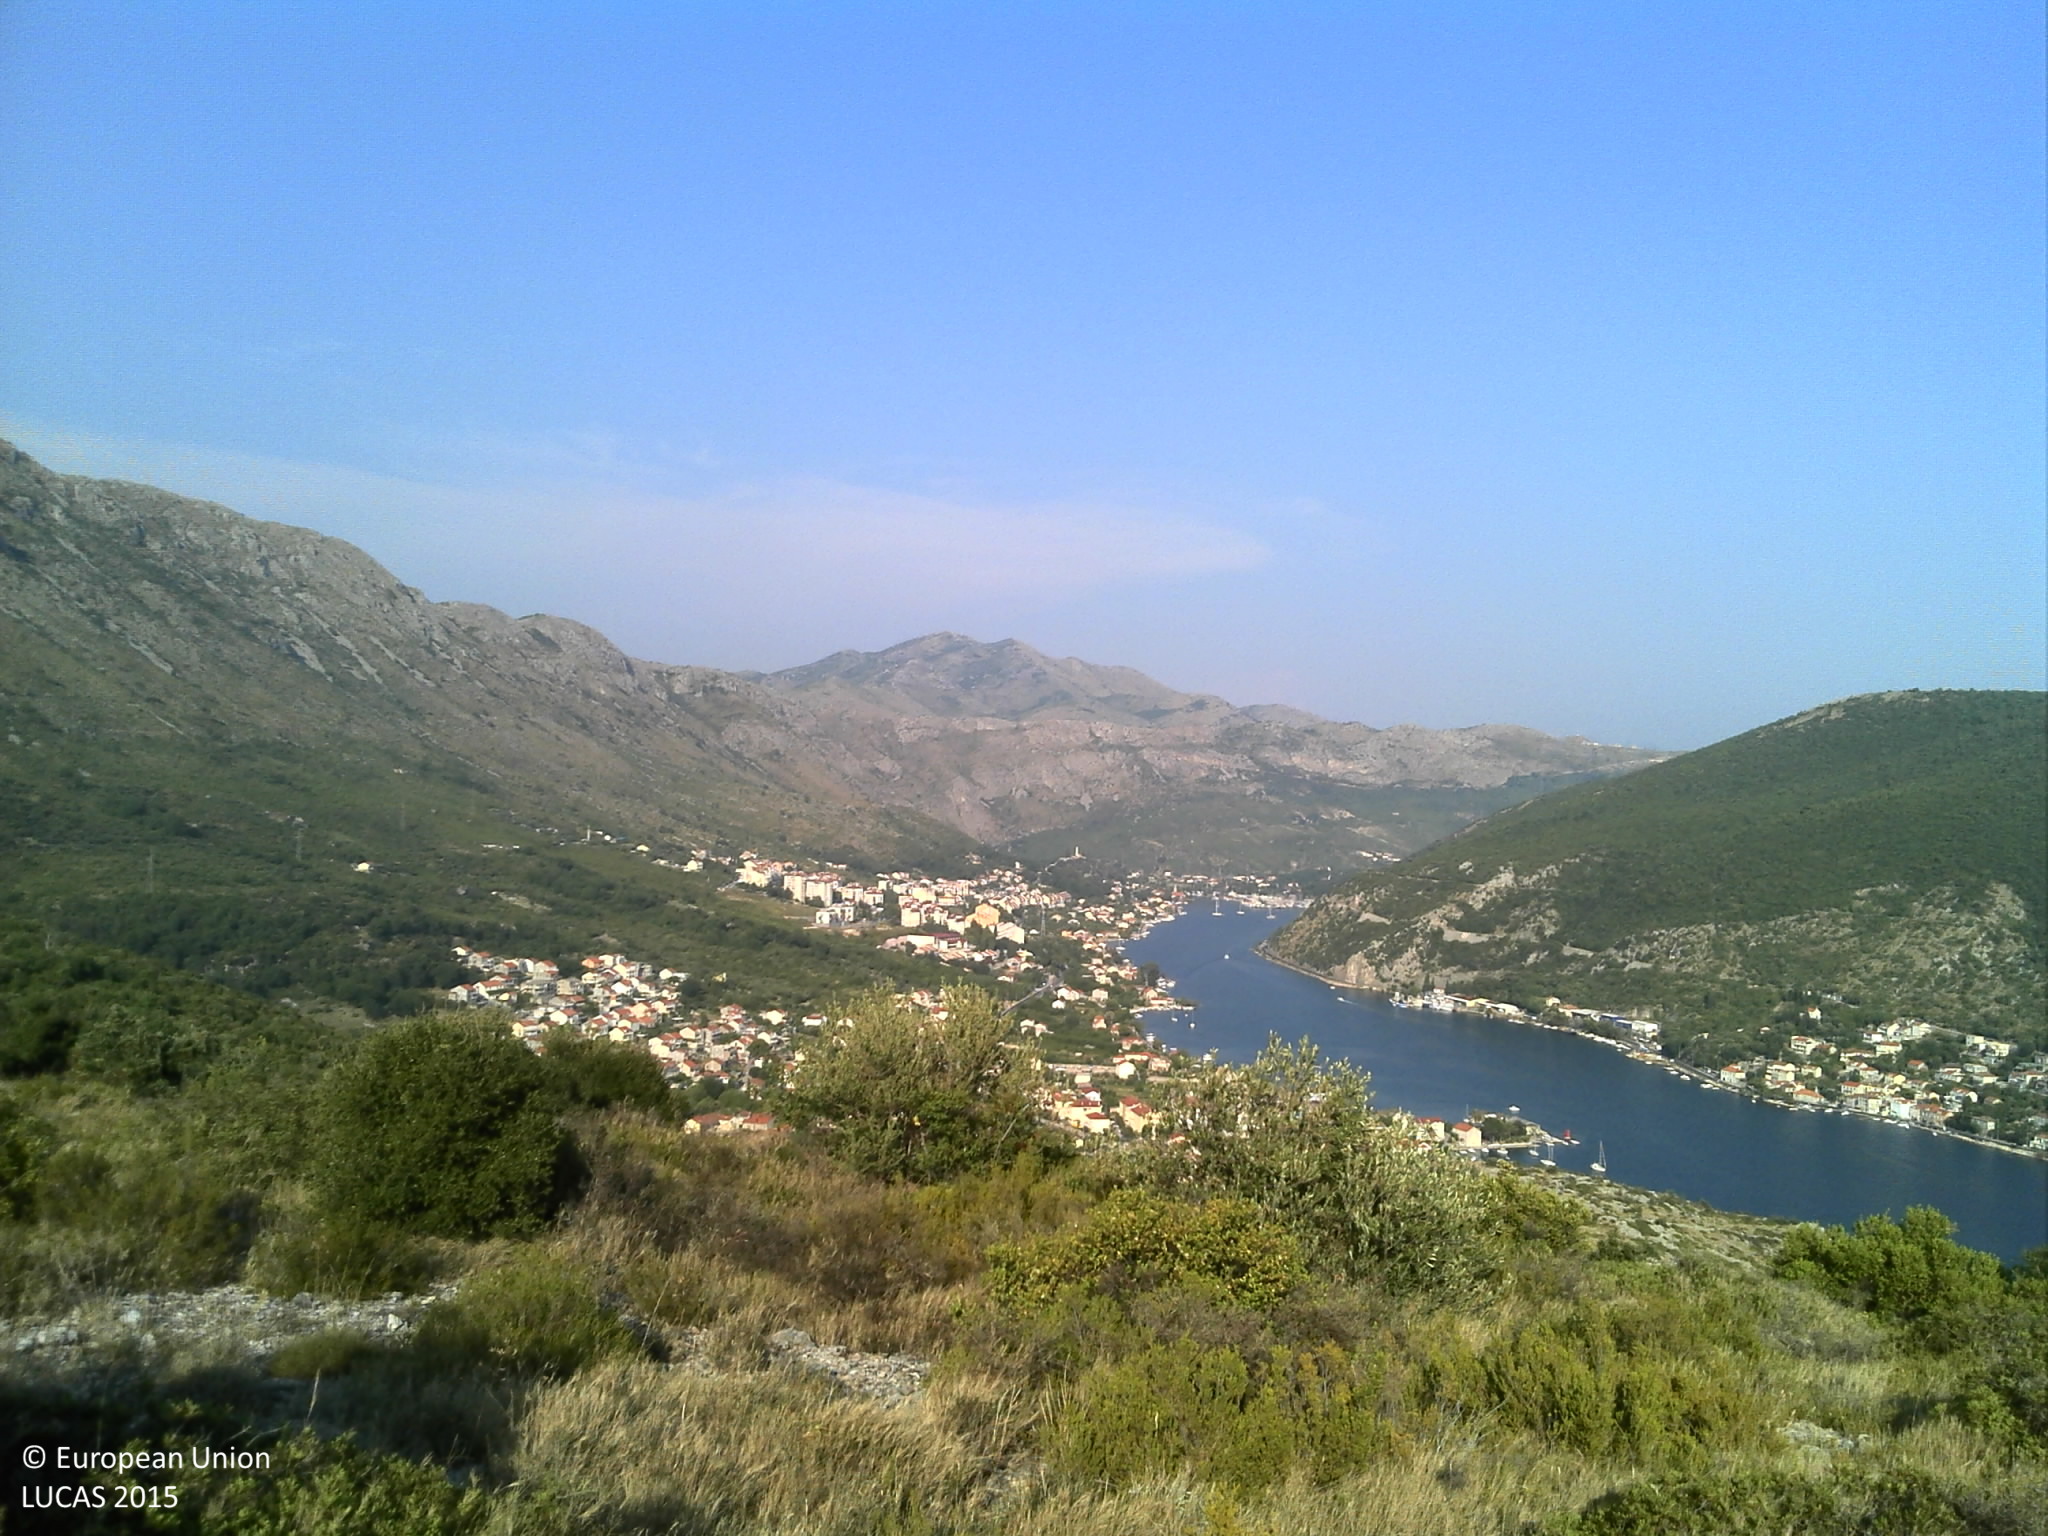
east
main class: Shrubland
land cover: Shrubland without tree cover
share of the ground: 50 - 75 %
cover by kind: shrubs 50 %, herbaceous plants 25 %, unconsolidated bare surface 15 %, consolidated bare surface 10 %
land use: Semi-natural and natural areas not in use
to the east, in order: Shrubland without tree cover; Paved roads, cycling and walking lanes; Shrubland with sparse tree cover; Paved roads, cycling and walking lanes; Shrubland with sparse tree cover; Paved roads, cycling and walking lanes
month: July
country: HR
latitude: 42.6754
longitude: 18.0807
